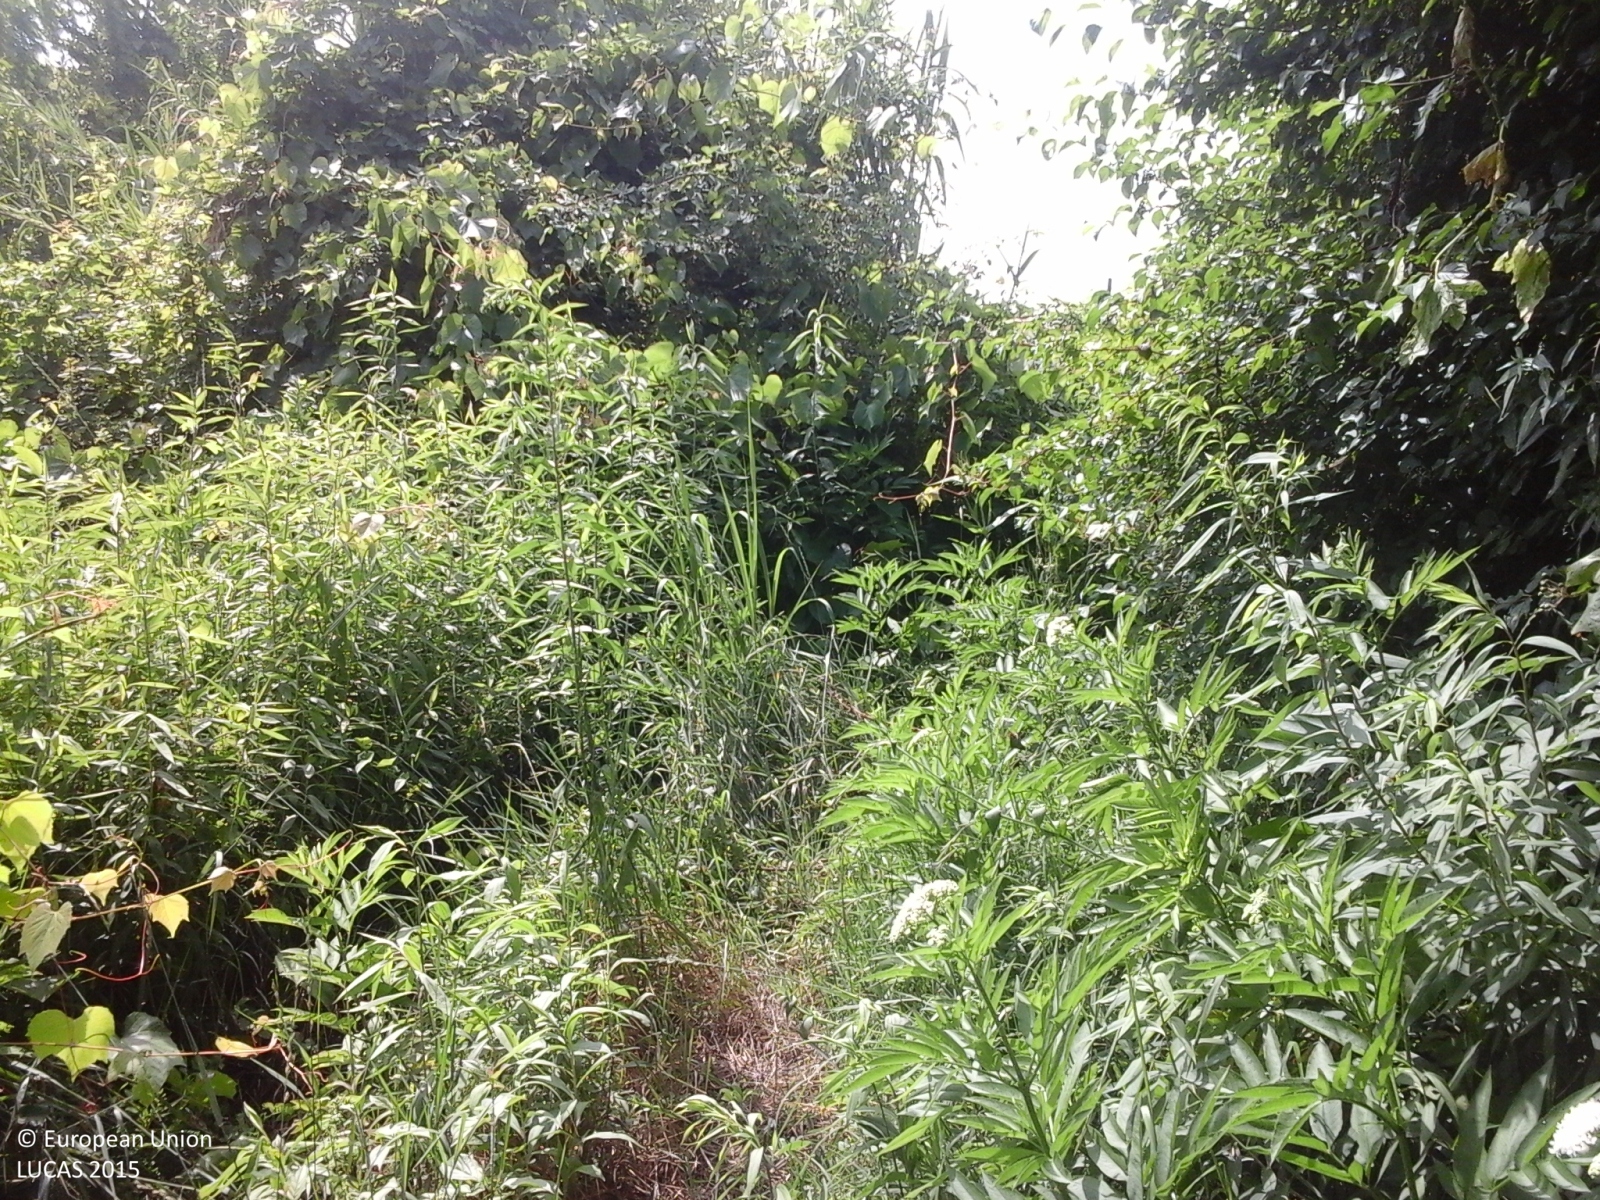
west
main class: Woodland
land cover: Broadleaved woodland
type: thermophilous deciduous forest
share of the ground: > 75 %
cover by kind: broadleaved forest trees 80 %, shrubs 10 %, herbaceous plants 10 %
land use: Semi-natural and natural areas not in use
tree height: > 5 m
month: June
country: IT
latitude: 45.0054
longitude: 8.3918
